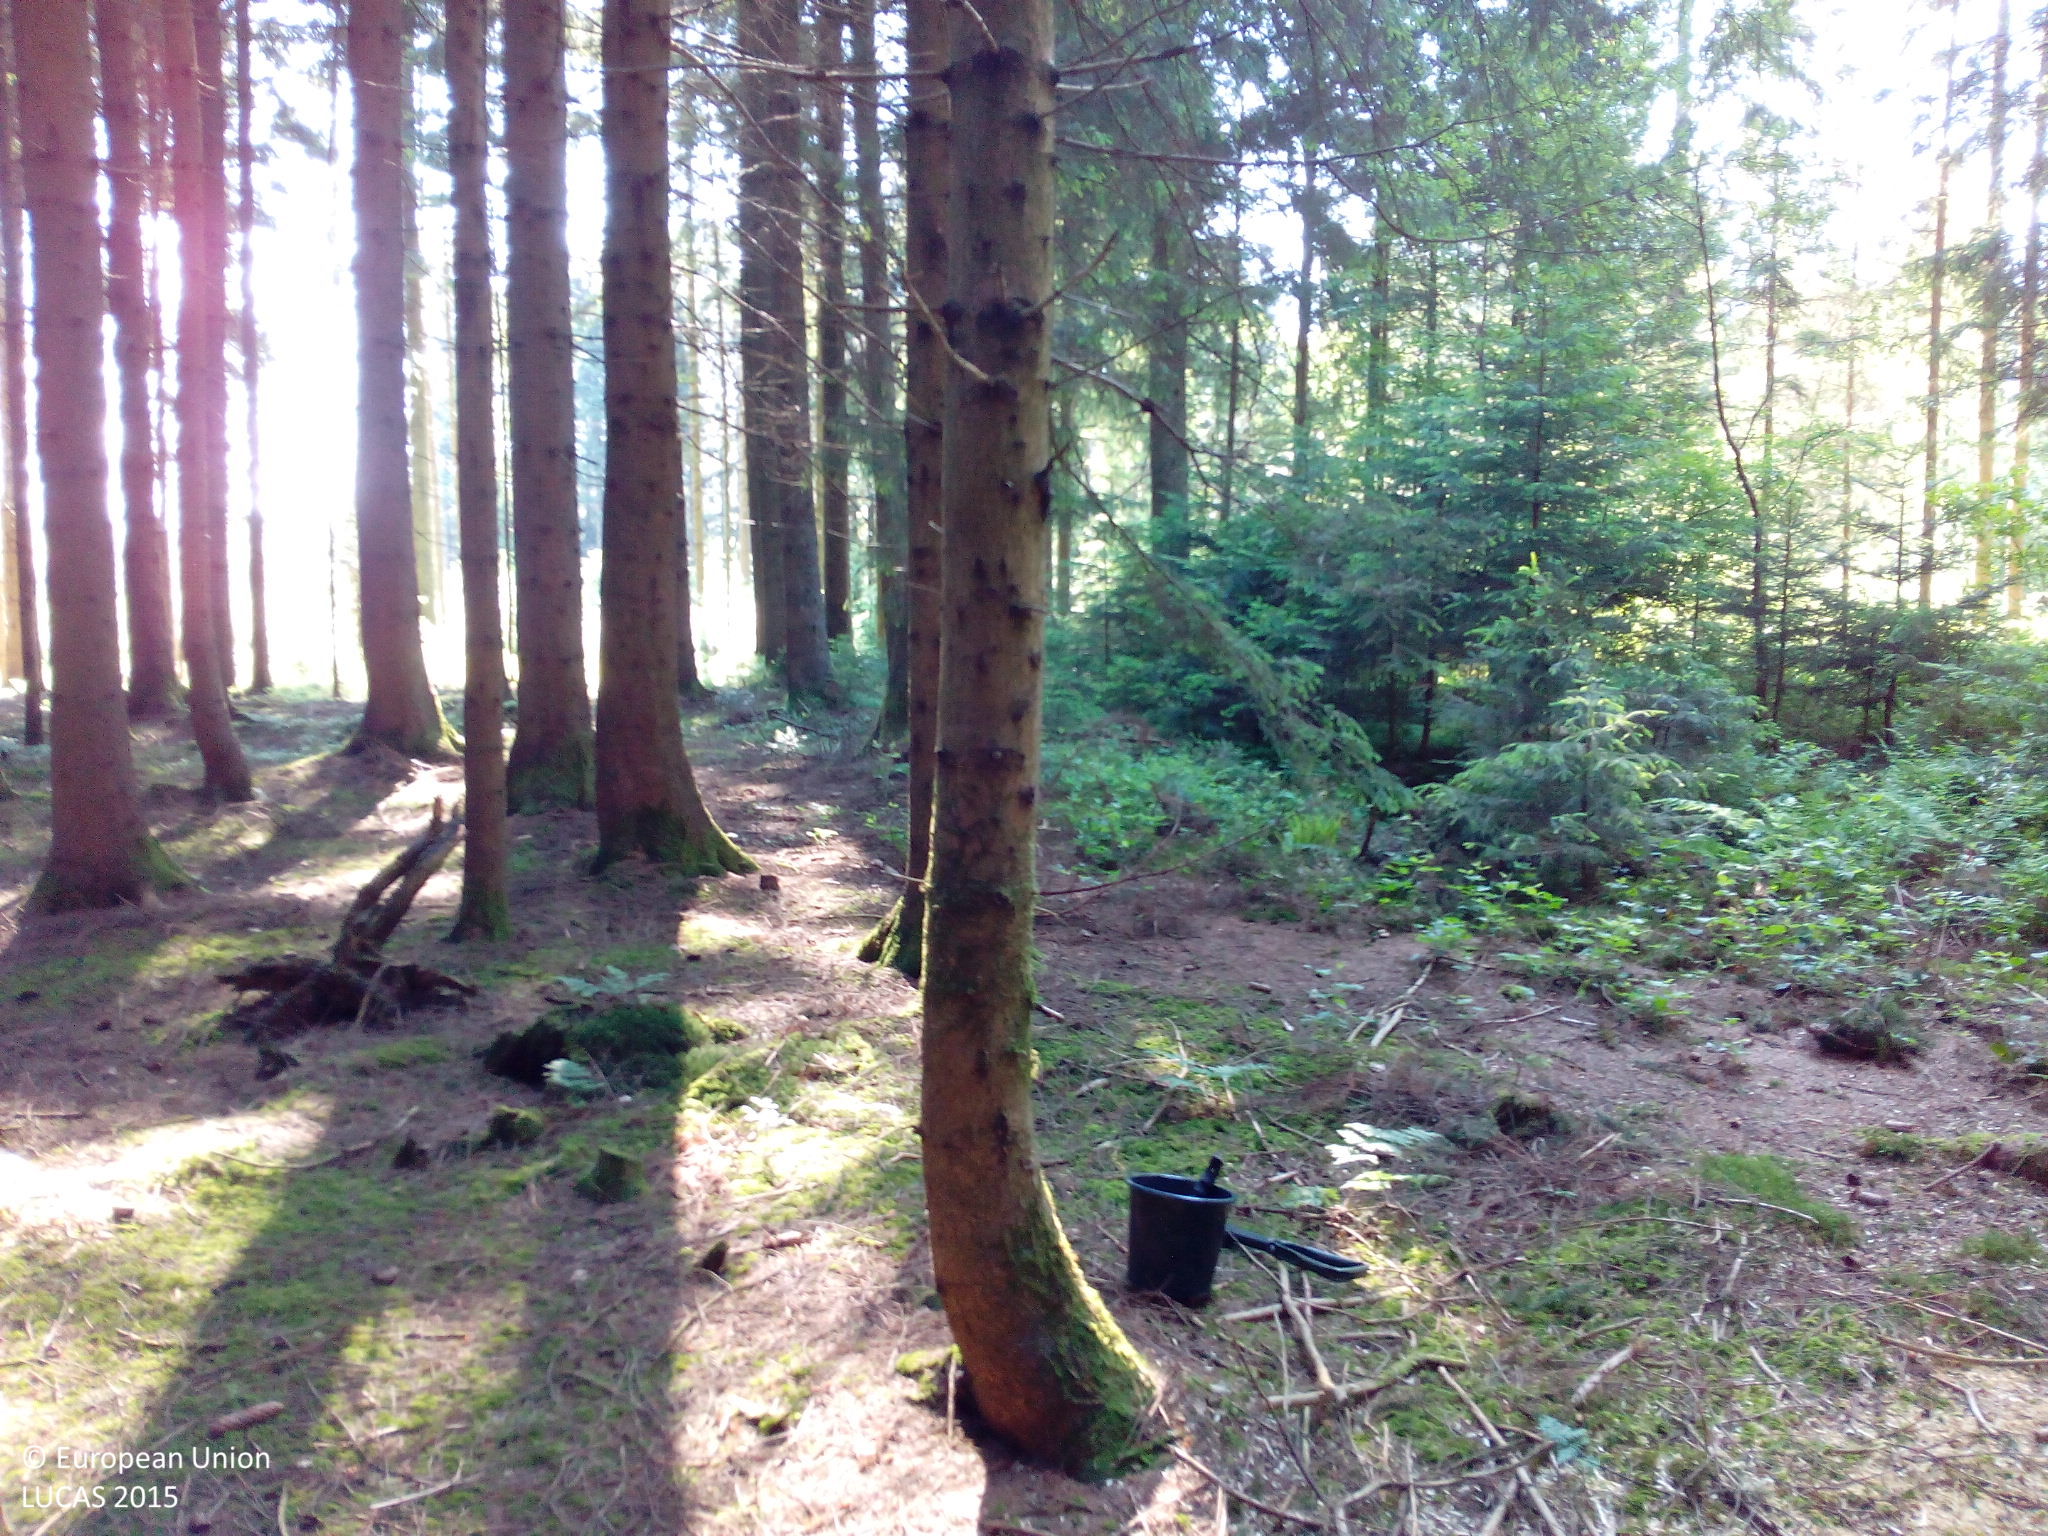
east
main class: Woodland
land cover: Spruce dominated coniferous woodland
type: hemiboreal forest and nemoral coniferous forest and mixed broadleaved-coniferous forest
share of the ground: > 75 %
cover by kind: coniferous forest trees 90 %, broadleaved forest trees 5 %, unconsolidated bare surface 5 %
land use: Forestry
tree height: > 5 m
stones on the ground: < 10 %
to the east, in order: Spruce dominated coniferous woodland; Tracks; Spruce dominated coniferous woodland; Tracks; Spontaneously vegetated surfaces; Spruce dominated mixed woodland; Tracks; Broadleaved woodland; Spruce dominated mixed woodland; Tracks; Grassland without tree/shrub cover
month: June
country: DE
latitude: 47.8927
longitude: 12.3393
